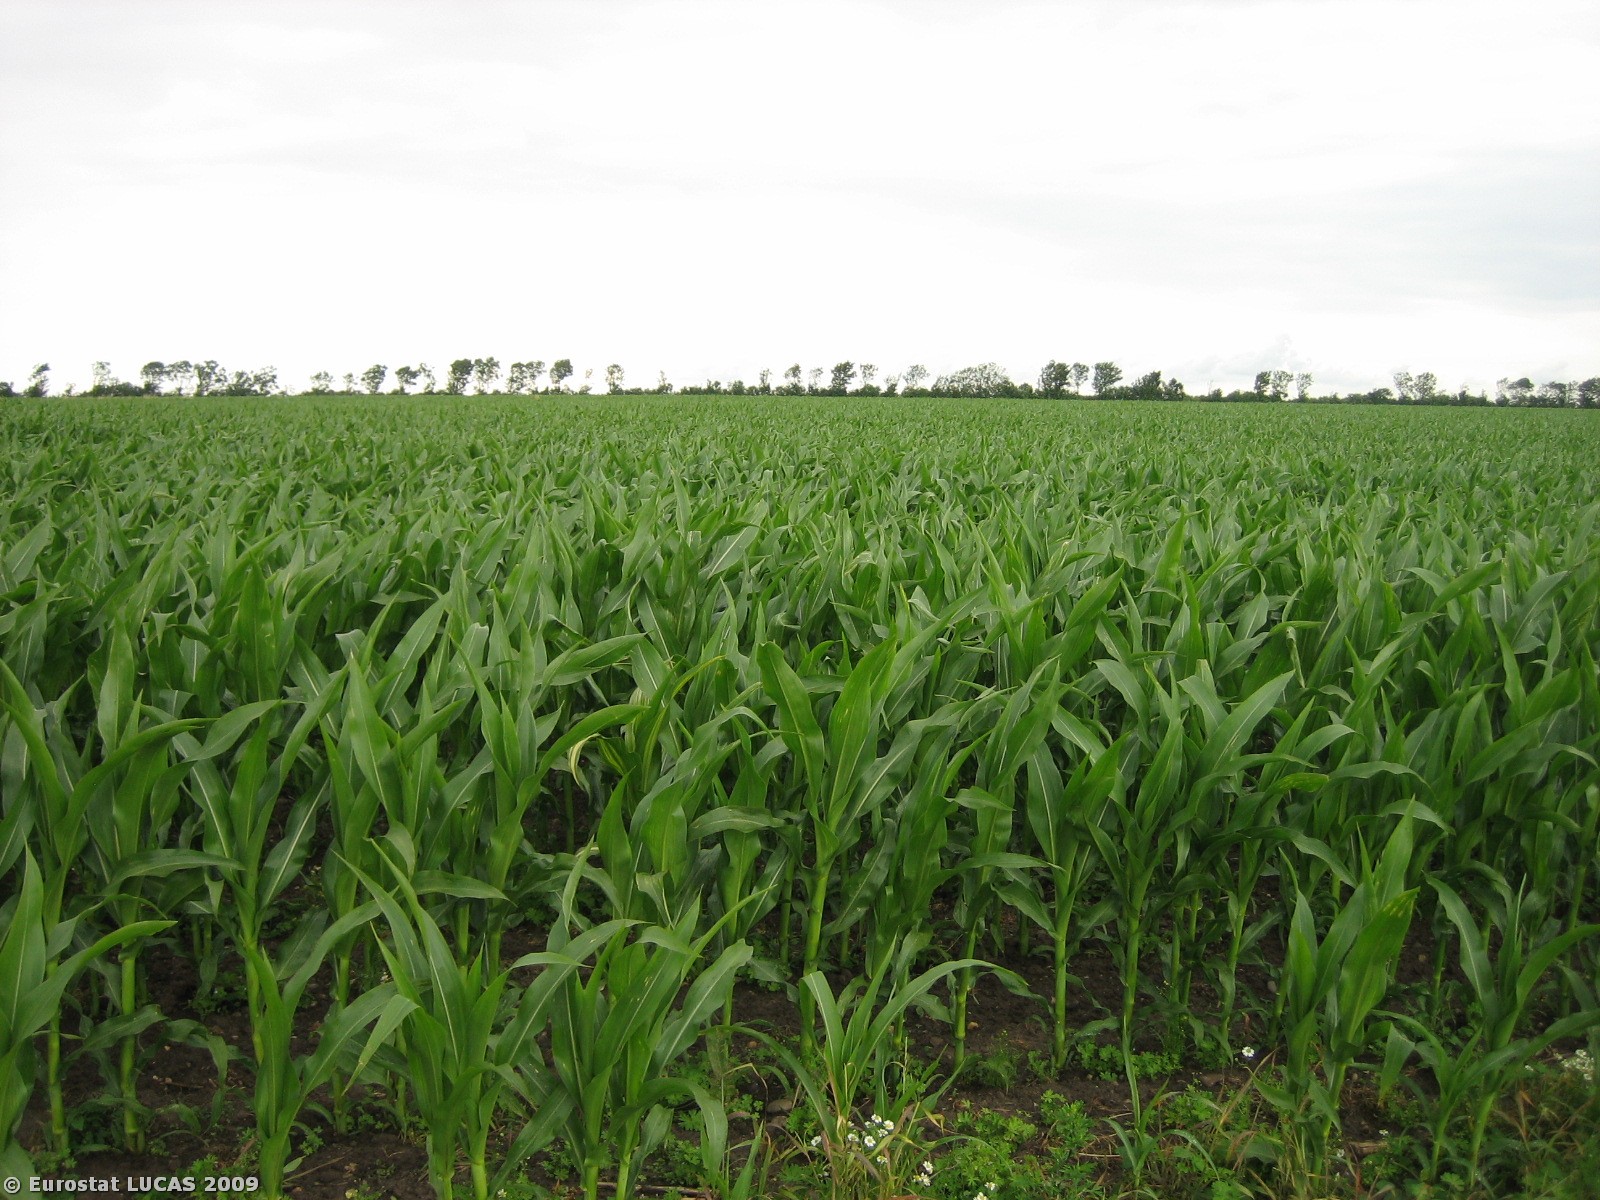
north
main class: Grassland
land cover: Grassland without tree/shrub cover
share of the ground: > 75 %
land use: Agriculture (excluding fallow land and kitchen gardens)
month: July
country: DK
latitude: 55.7638
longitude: 8.3600
